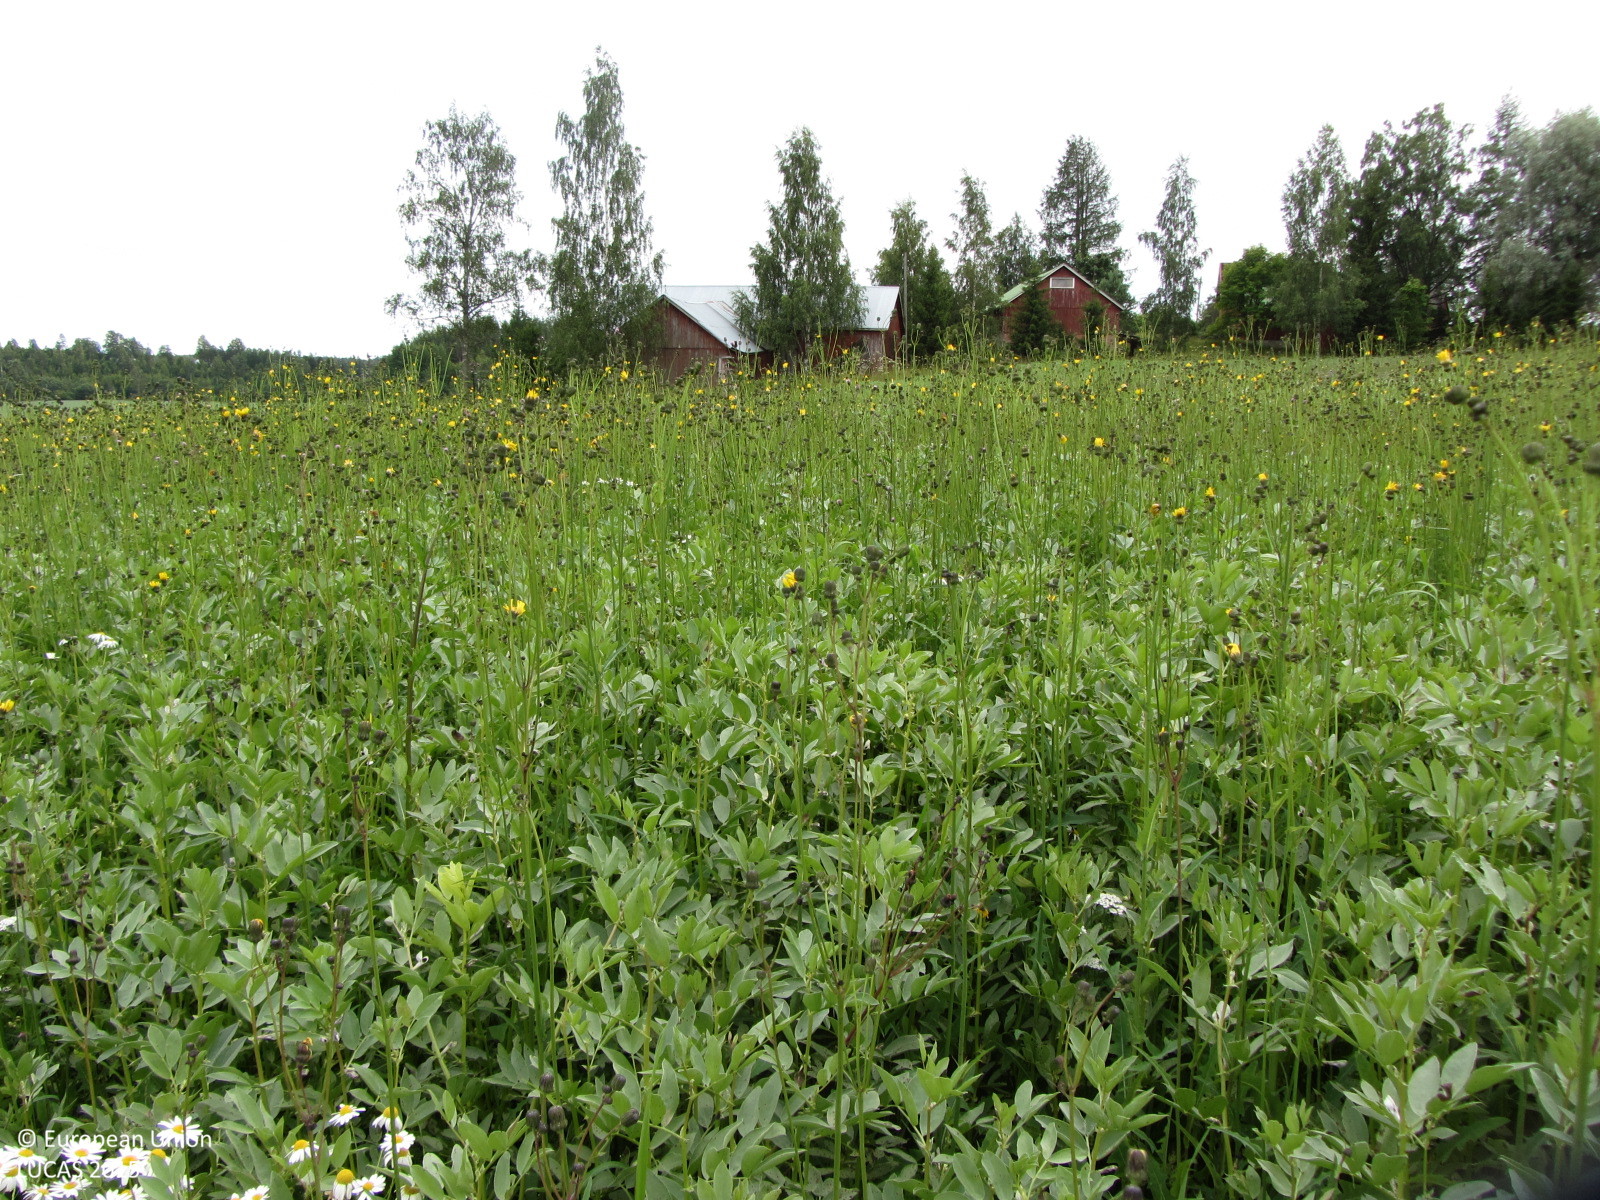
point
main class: Cropland
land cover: Dry pulses
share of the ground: > 75 %
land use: Agriculture (excluding fallow land and kitchen gardens)
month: July
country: FI
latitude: 60.4838
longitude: 24.2025
